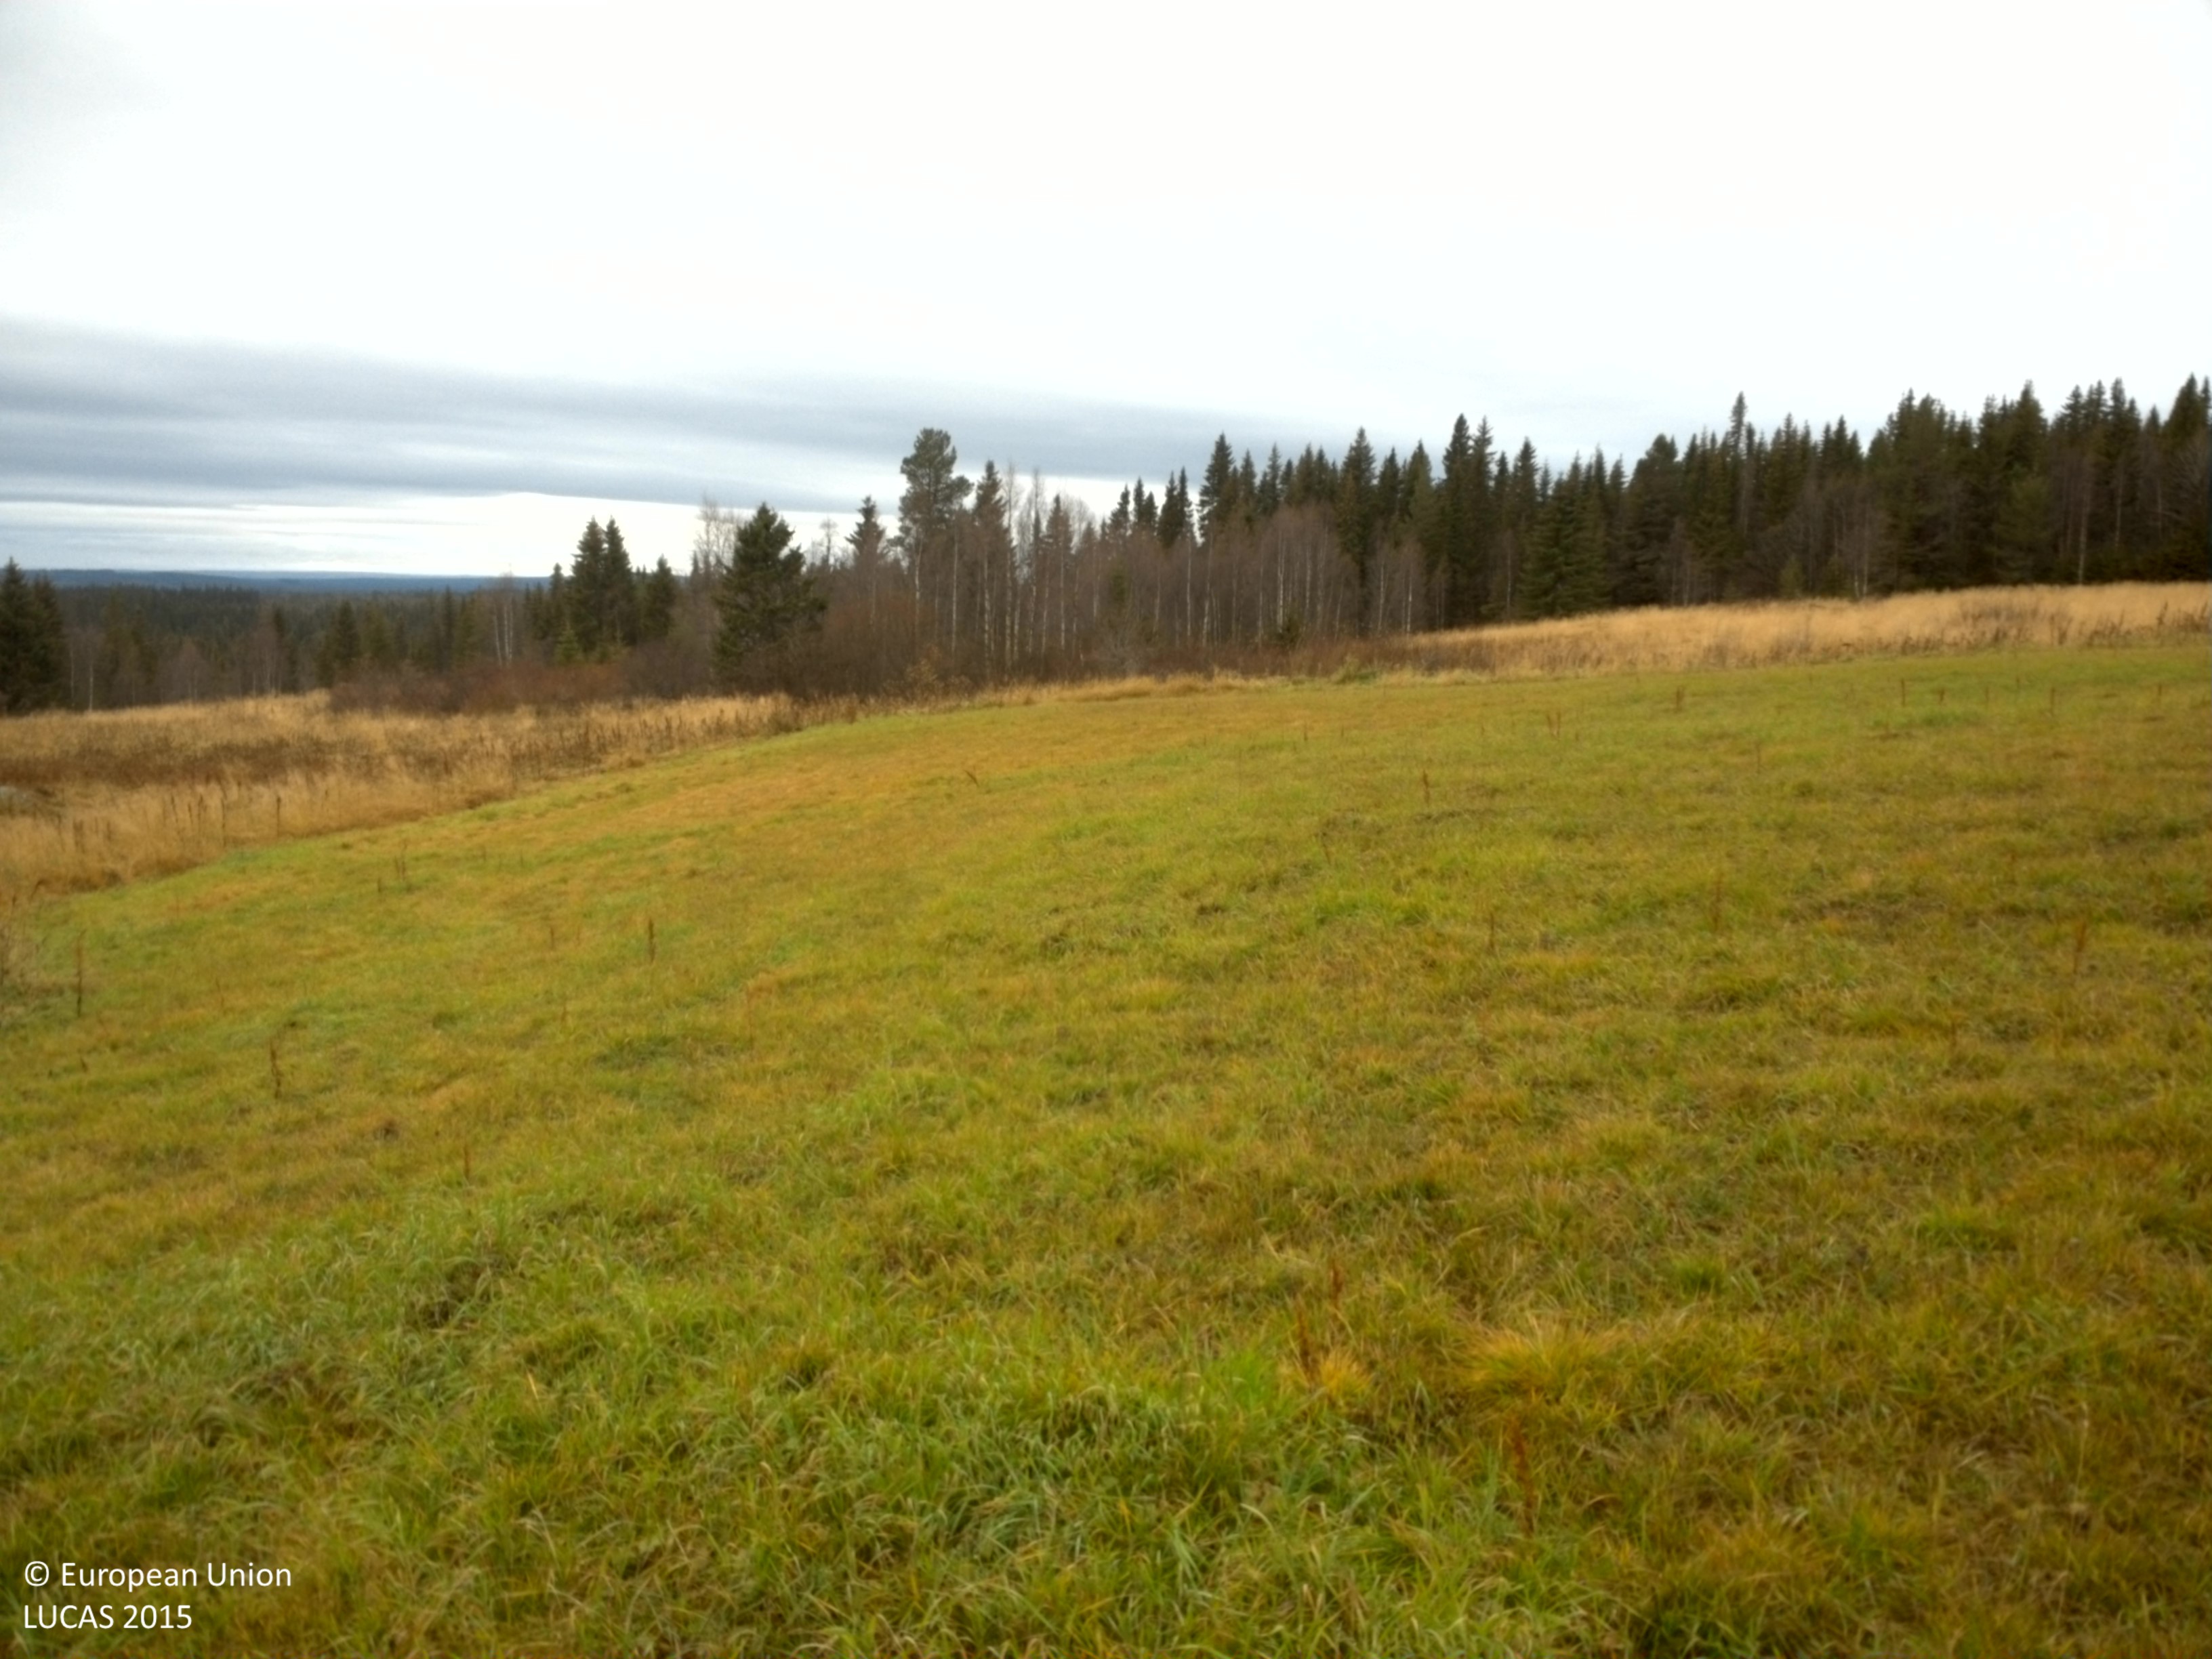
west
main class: Cropland
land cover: Temporary grasslands
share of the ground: > 75 %
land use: Agriculture (excluding fallow land and kitchen gardens)
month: October
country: SE
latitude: 64.5535
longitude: 17.3718
